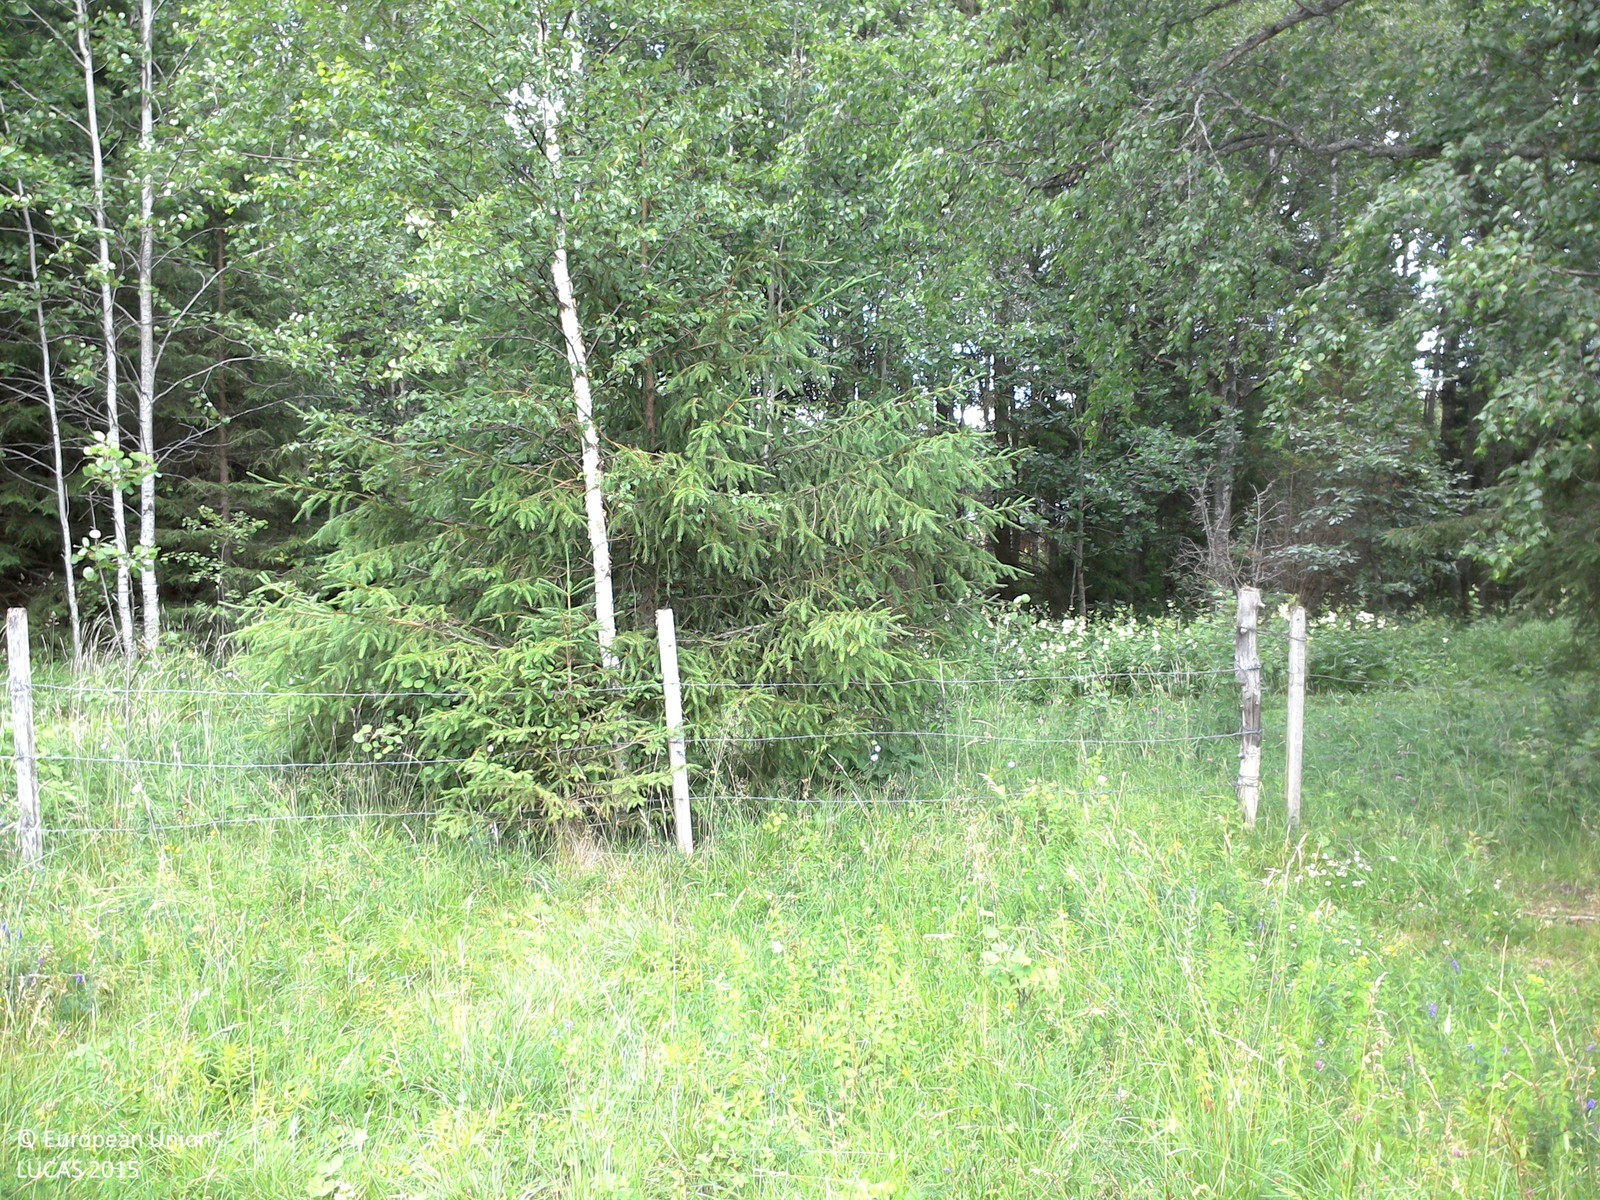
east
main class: Grassland
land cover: Grassland with sparse tree/shrub cover
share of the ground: > 75 %
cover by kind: herbaceous plants 95 %, broadleaved forest trees 5 %
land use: Agriculture (excluding fallow land and kitchen gardens)
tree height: > 5 m
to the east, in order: Grassland with sparse tree/shrub cover; Fences; Spruce dominated coniferous woodland; Tracks; Rivers and streams; Spruce dominated mixed woodland; Tracks; Spruce dominated coniferous woodland; Tracks; Spruce dominated coniferous woodland; Tracks; Spruce dominated coniferous woodland; Fences; Spruce dominated mixed woodland
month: July
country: SE
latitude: 58.0153
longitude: 14.5817
